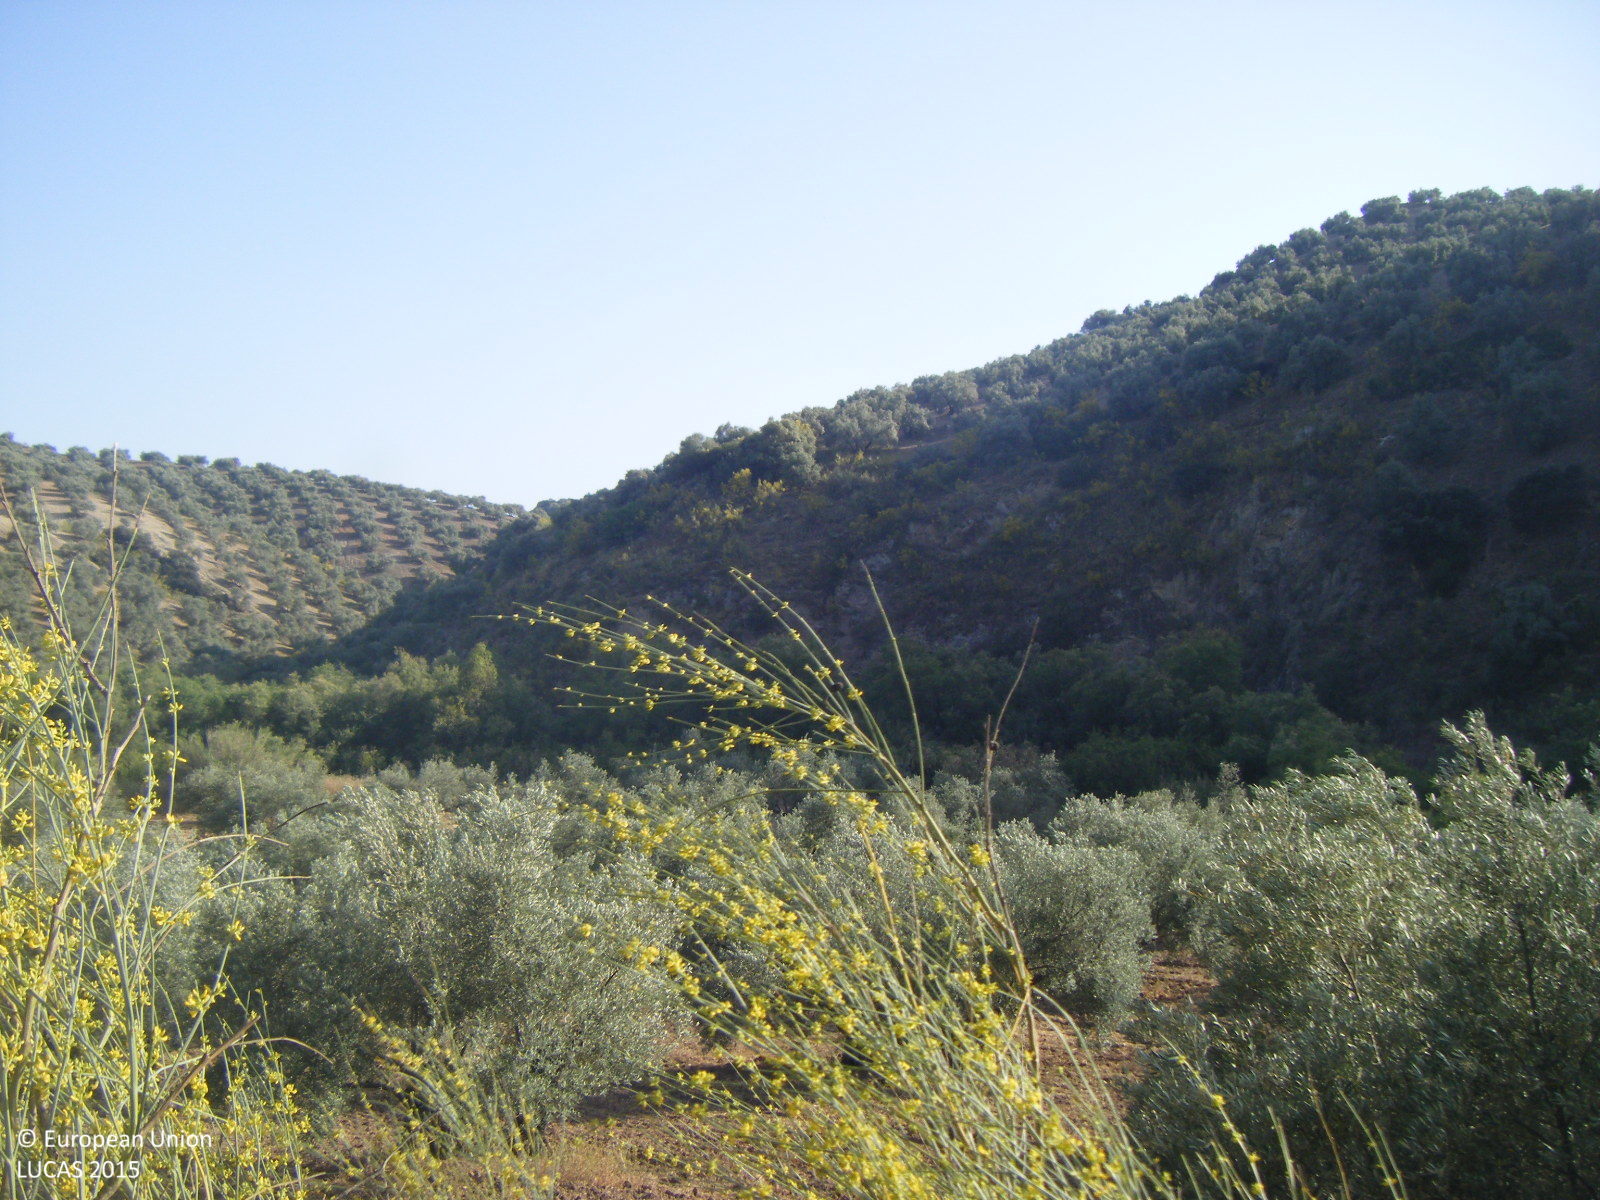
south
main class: Cropland
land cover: Olive groves
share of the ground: 10 - 25 %
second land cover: Shrubland without tree cover
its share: 10 - 25 %
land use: Agriculture (excluding fallow land and kitchen gardens)
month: May
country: ES
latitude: 37.3390
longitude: -4.5516
